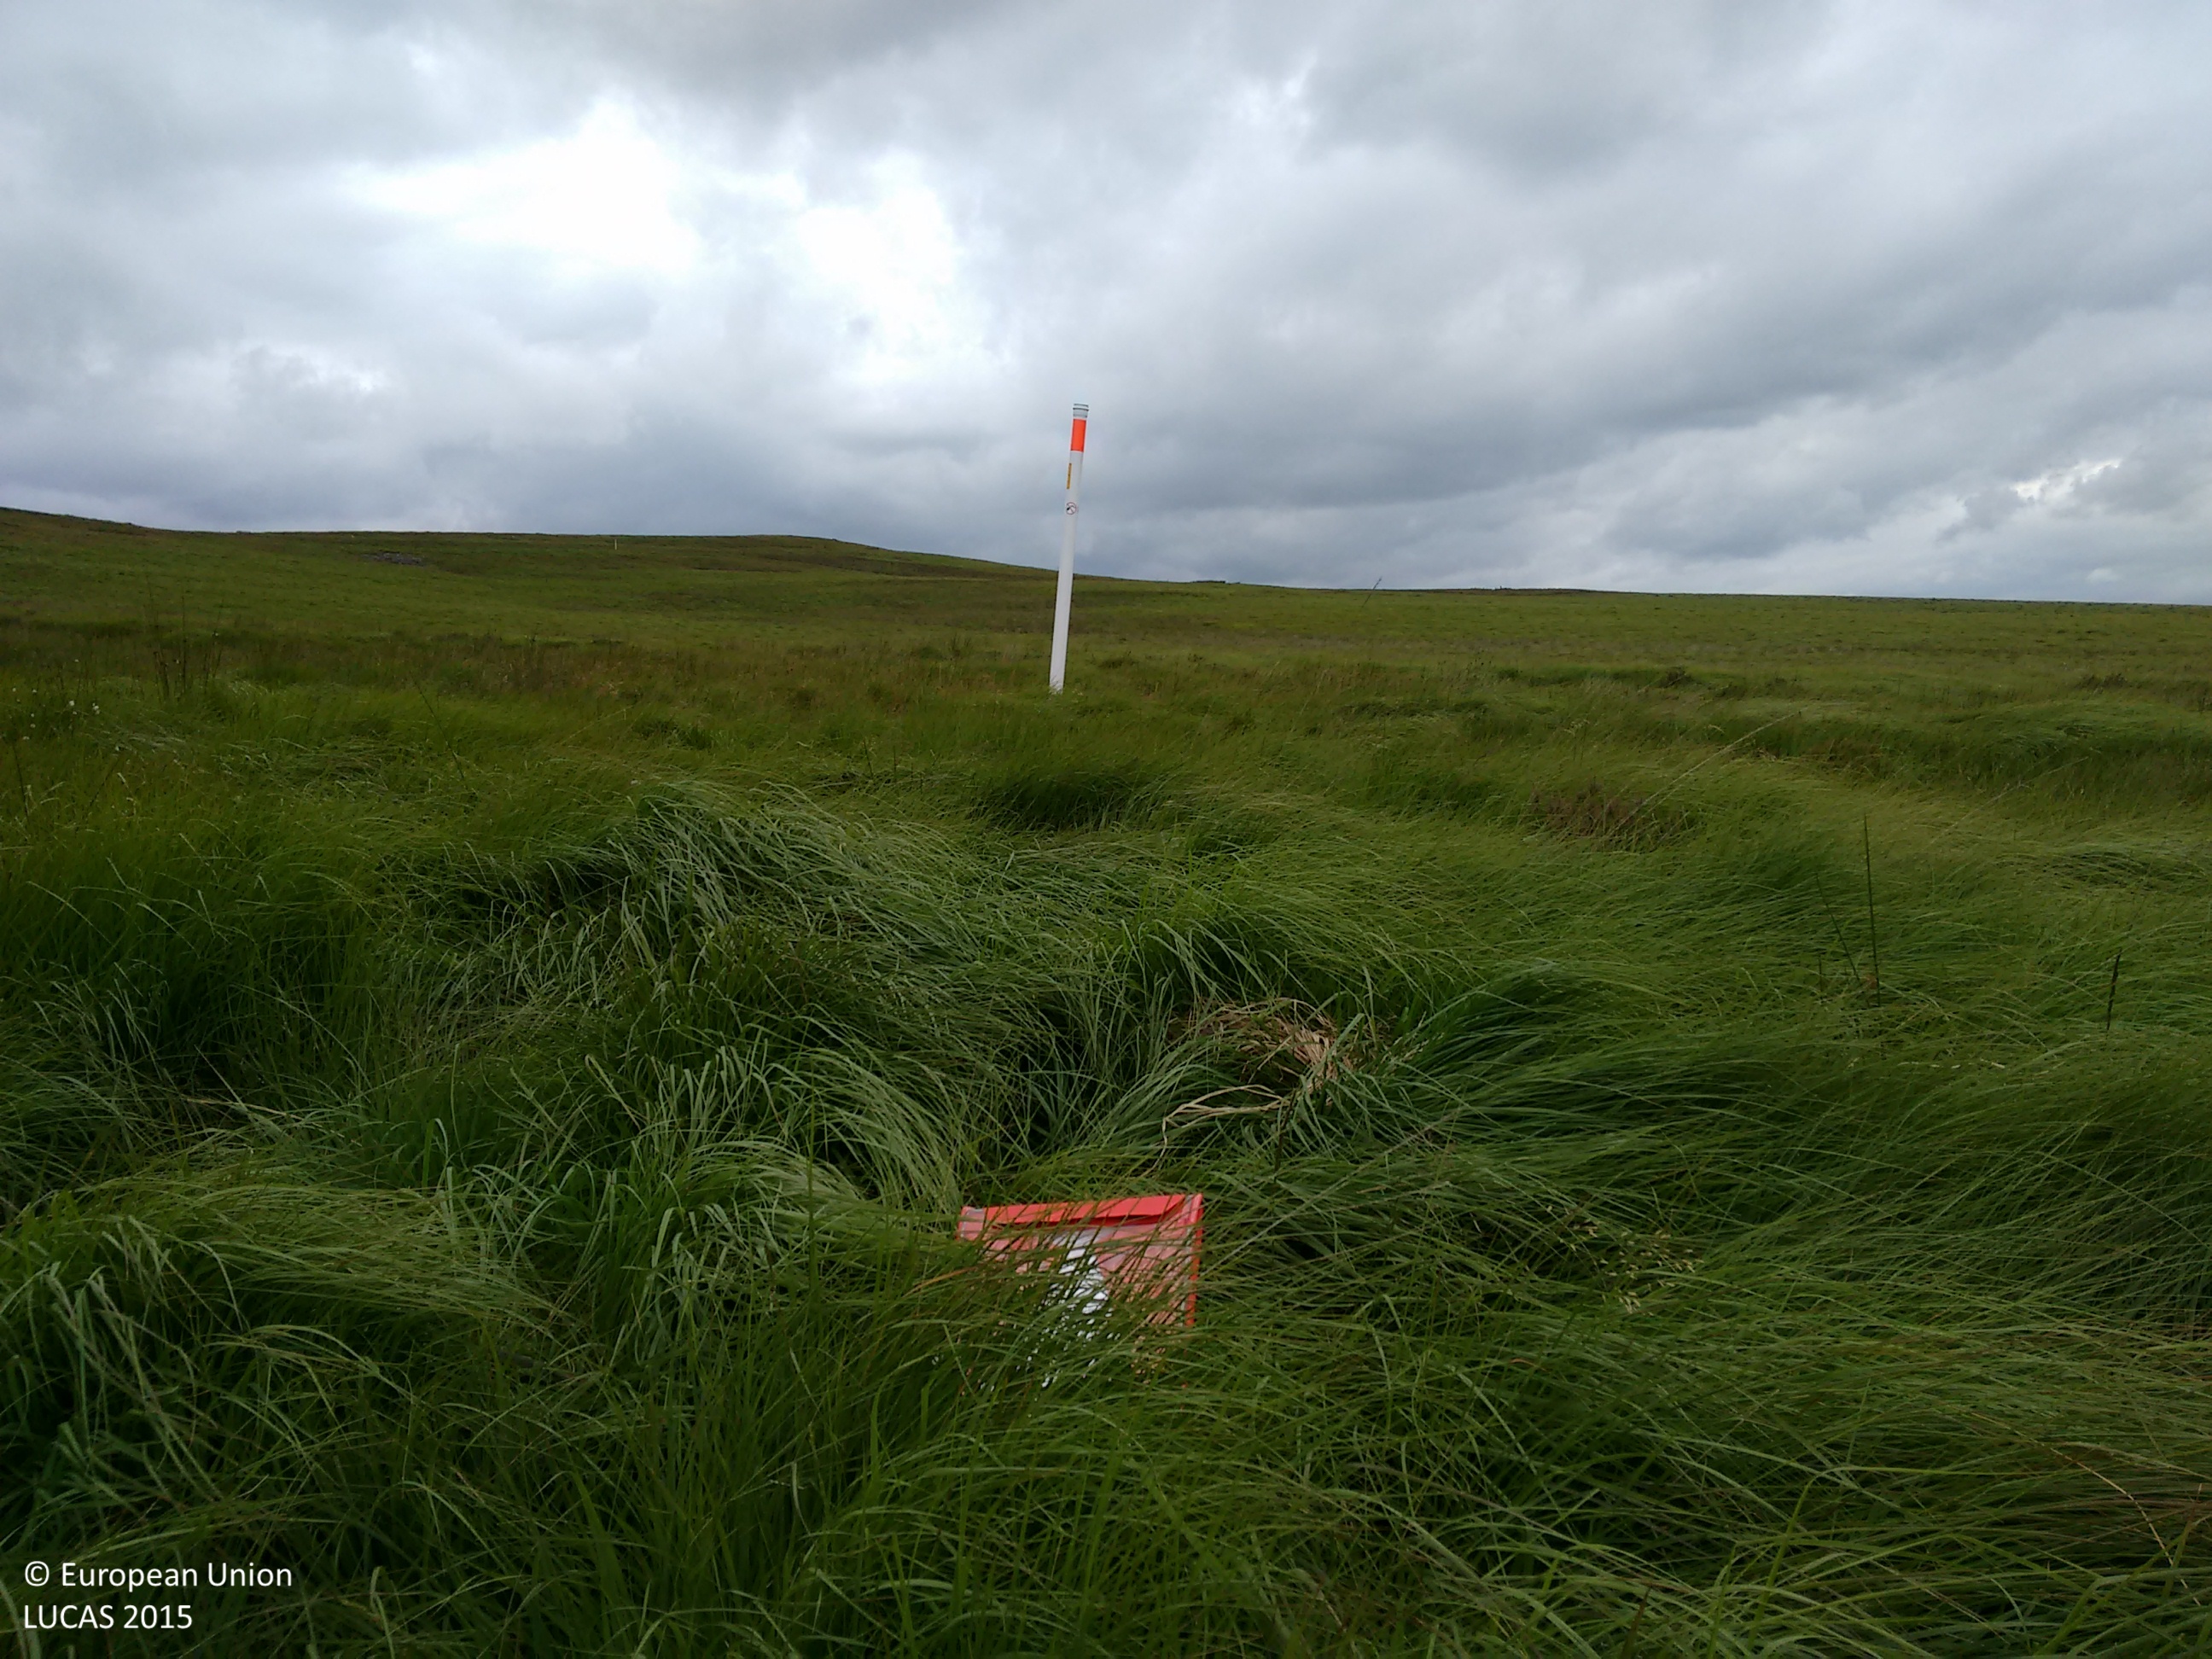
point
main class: Grassland
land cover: Grassland without tree/shrub cover
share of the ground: > 75 %
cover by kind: herbaceous plants 100 %
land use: Semi-natural and natural areas not in use
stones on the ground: < 10 %
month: July
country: GB
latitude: 51.7888
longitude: -3.1400
